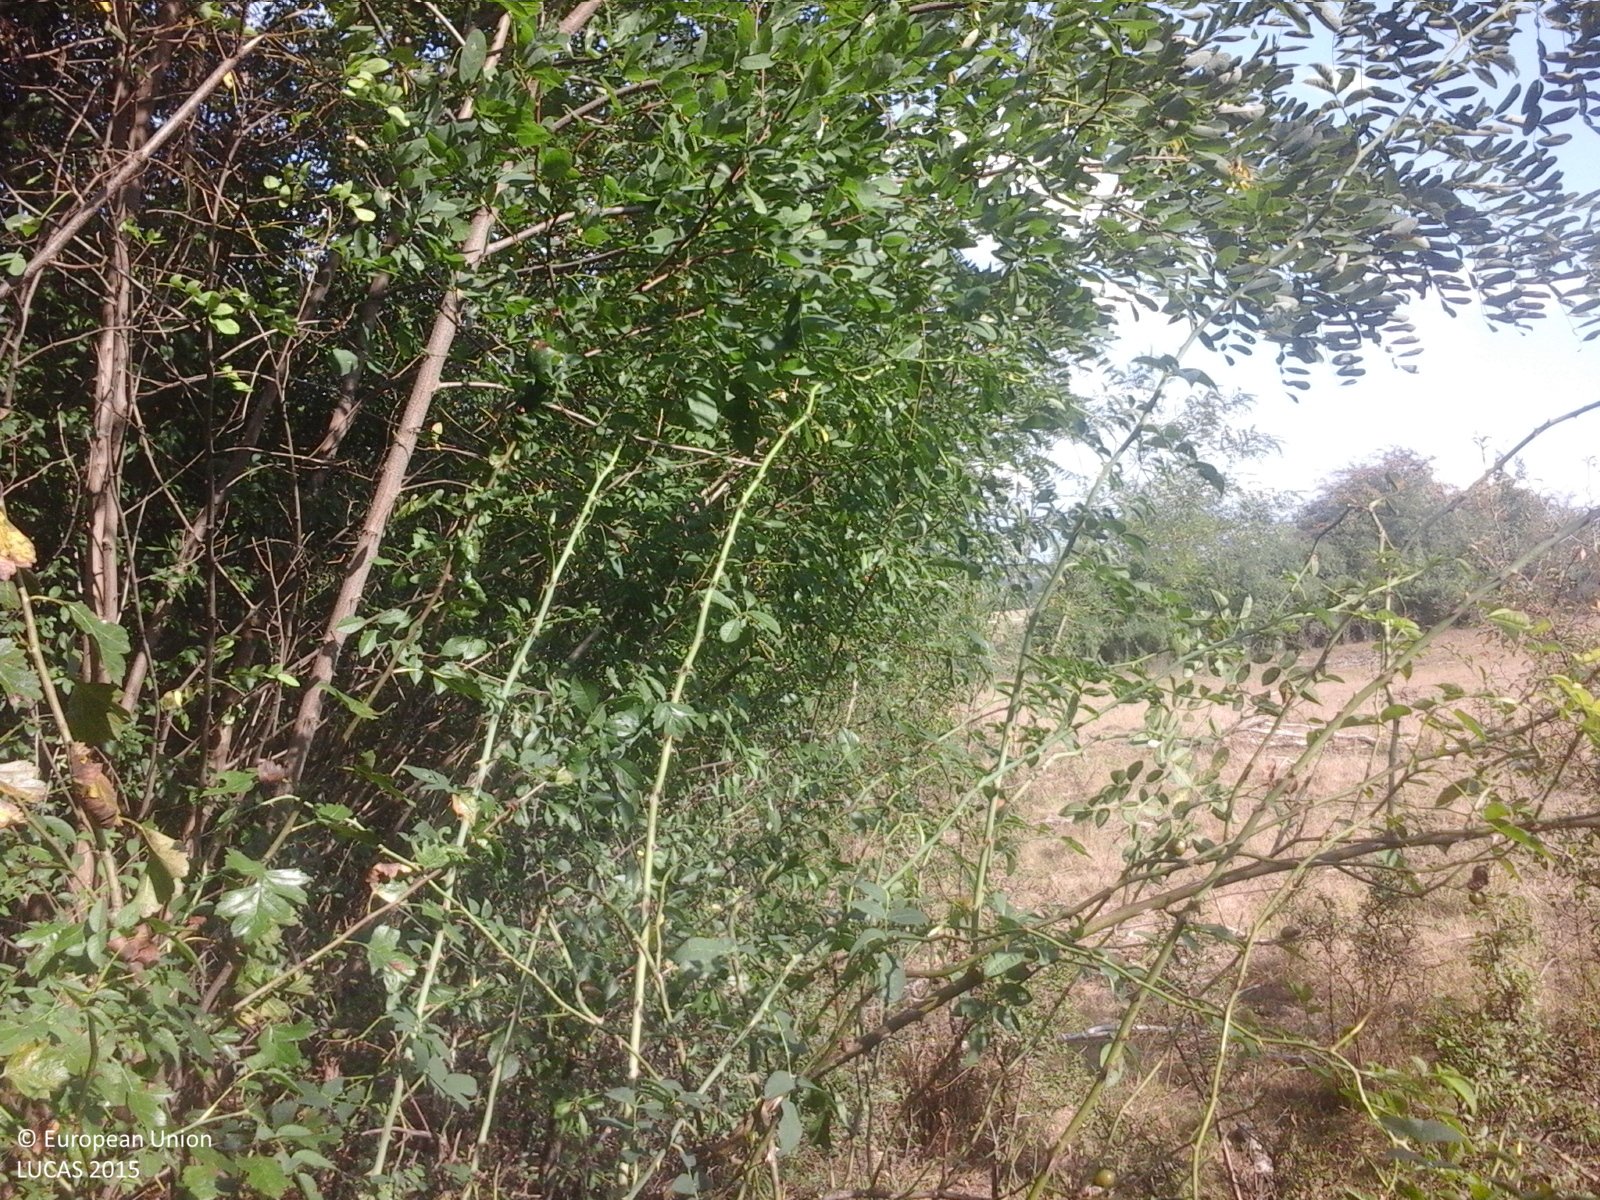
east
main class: Woodland
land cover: Broadleaved woodland
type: exotic forest
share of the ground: > 75 %
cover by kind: broadleaved forest trees 100 %
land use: Forestry
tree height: > 5 m
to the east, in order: Broadleaved woodland; Grassland with sparse tree/shrub cover; Spontaneously vegetated surfaces; Inland marshes; Shrubland without tree cover
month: September
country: RO
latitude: 47.4168
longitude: 23.1222
